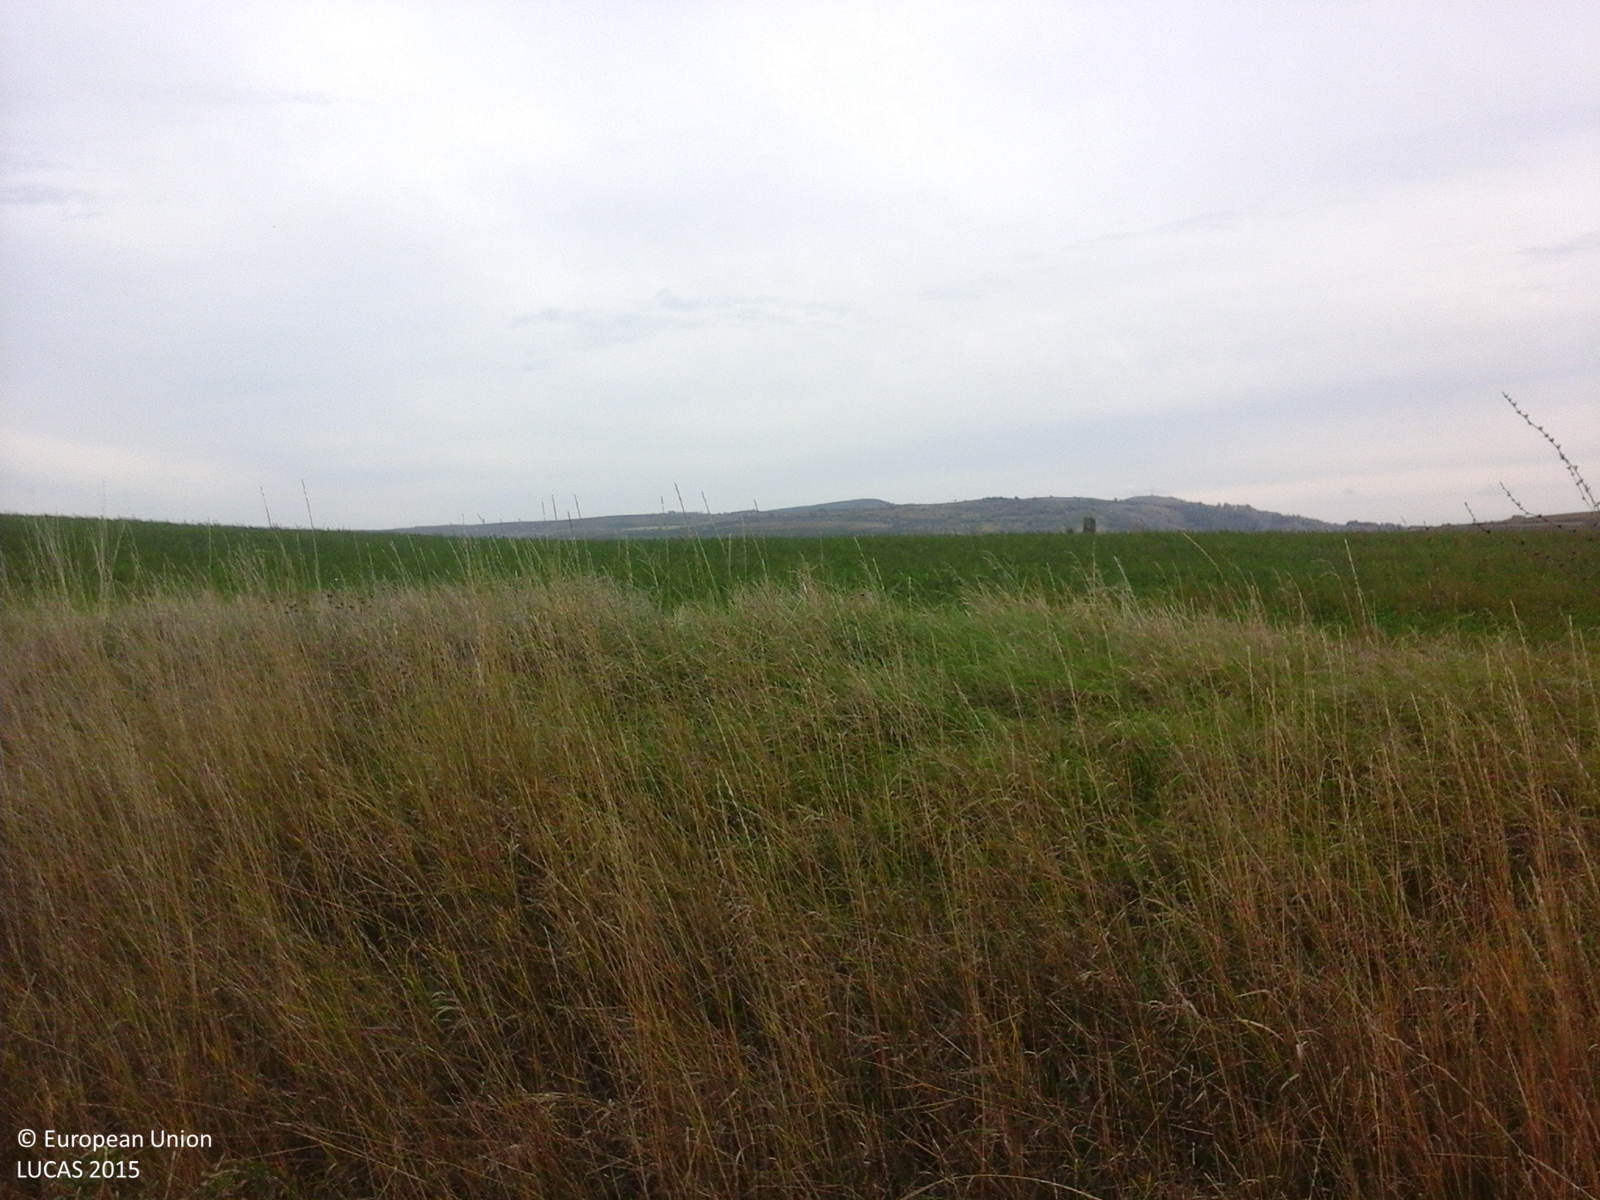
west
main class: Grassland
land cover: Spontaneously vegetated surfaces
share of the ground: > 75 %
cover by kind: herbaceous plants 100 %
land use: Semi-natural and natural areas not in use
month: October
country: RO
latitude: 45.0096
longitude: 26.3448
